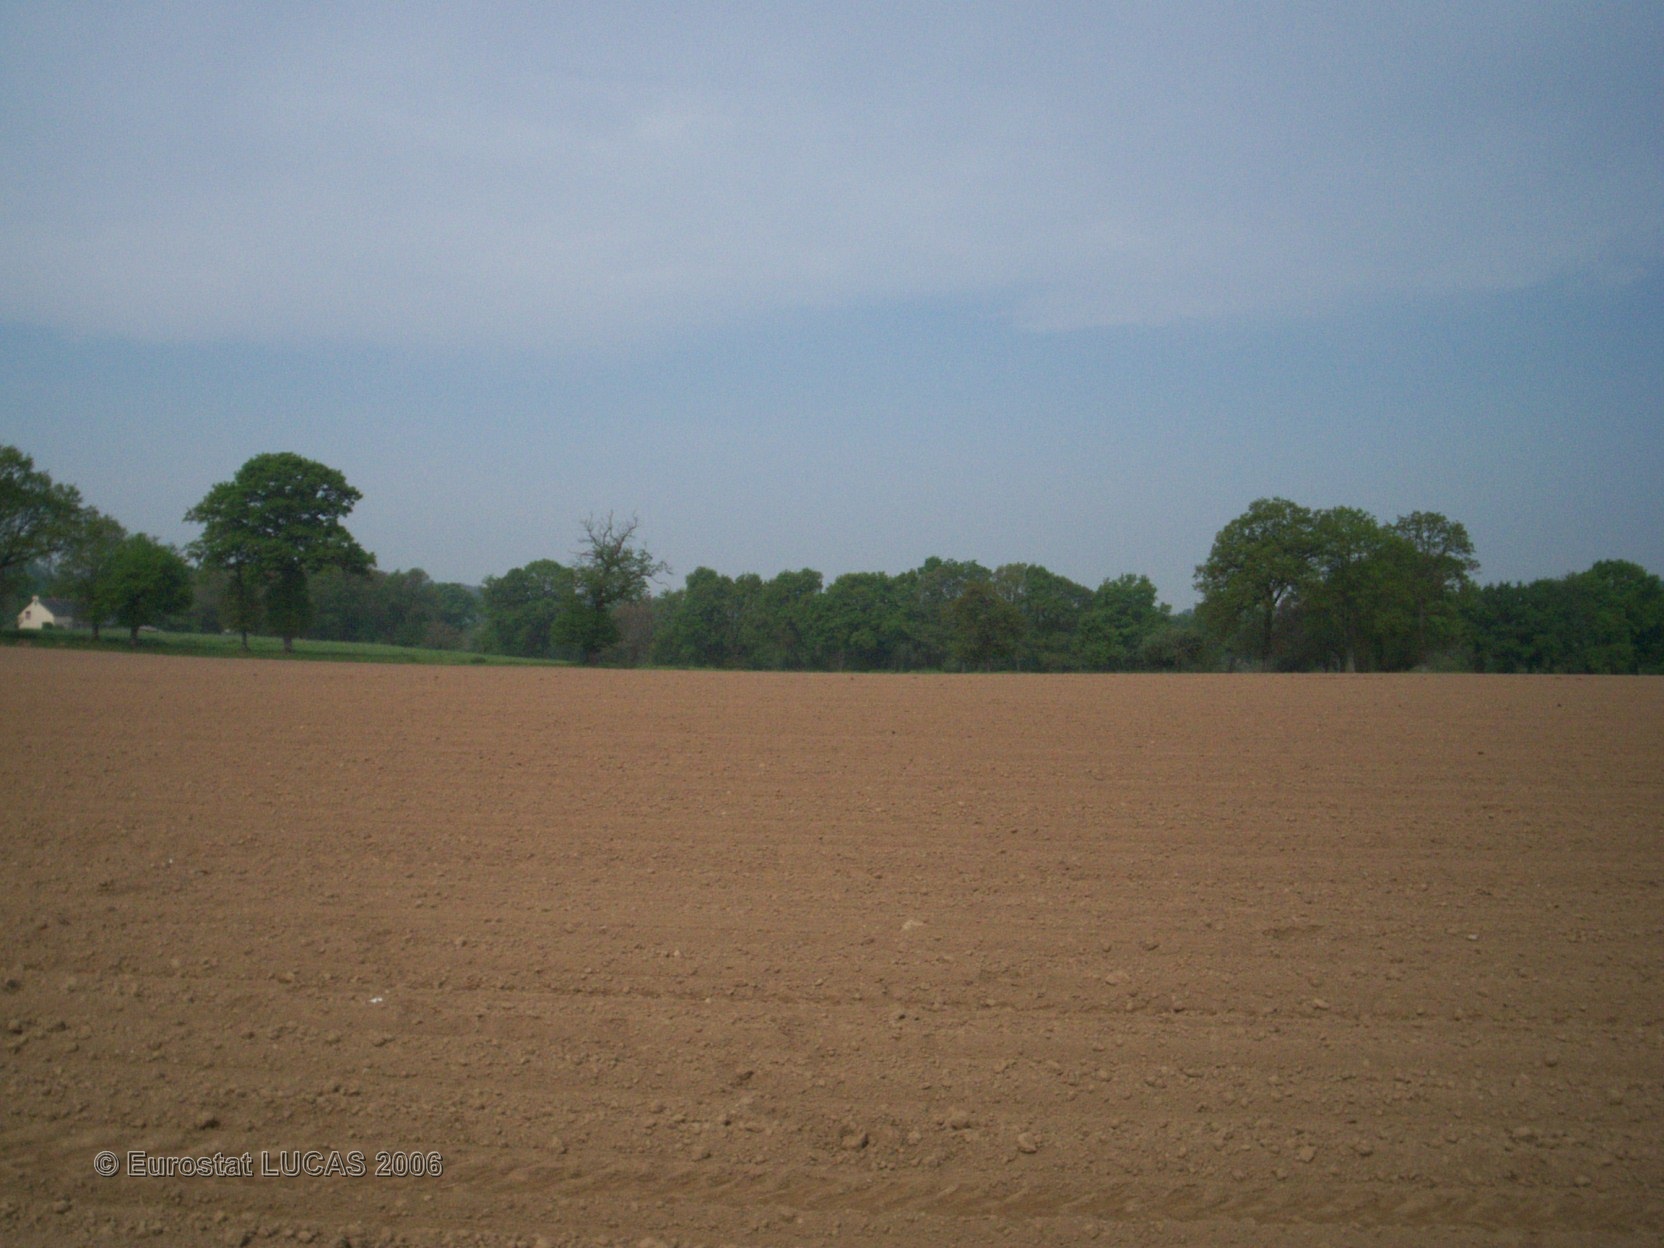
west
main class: Cropland
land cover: Maize
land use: Agriculture (excluding fallow land and kitchen gardens)
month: May
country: FR
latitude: 47.7633
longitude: -2.3438
